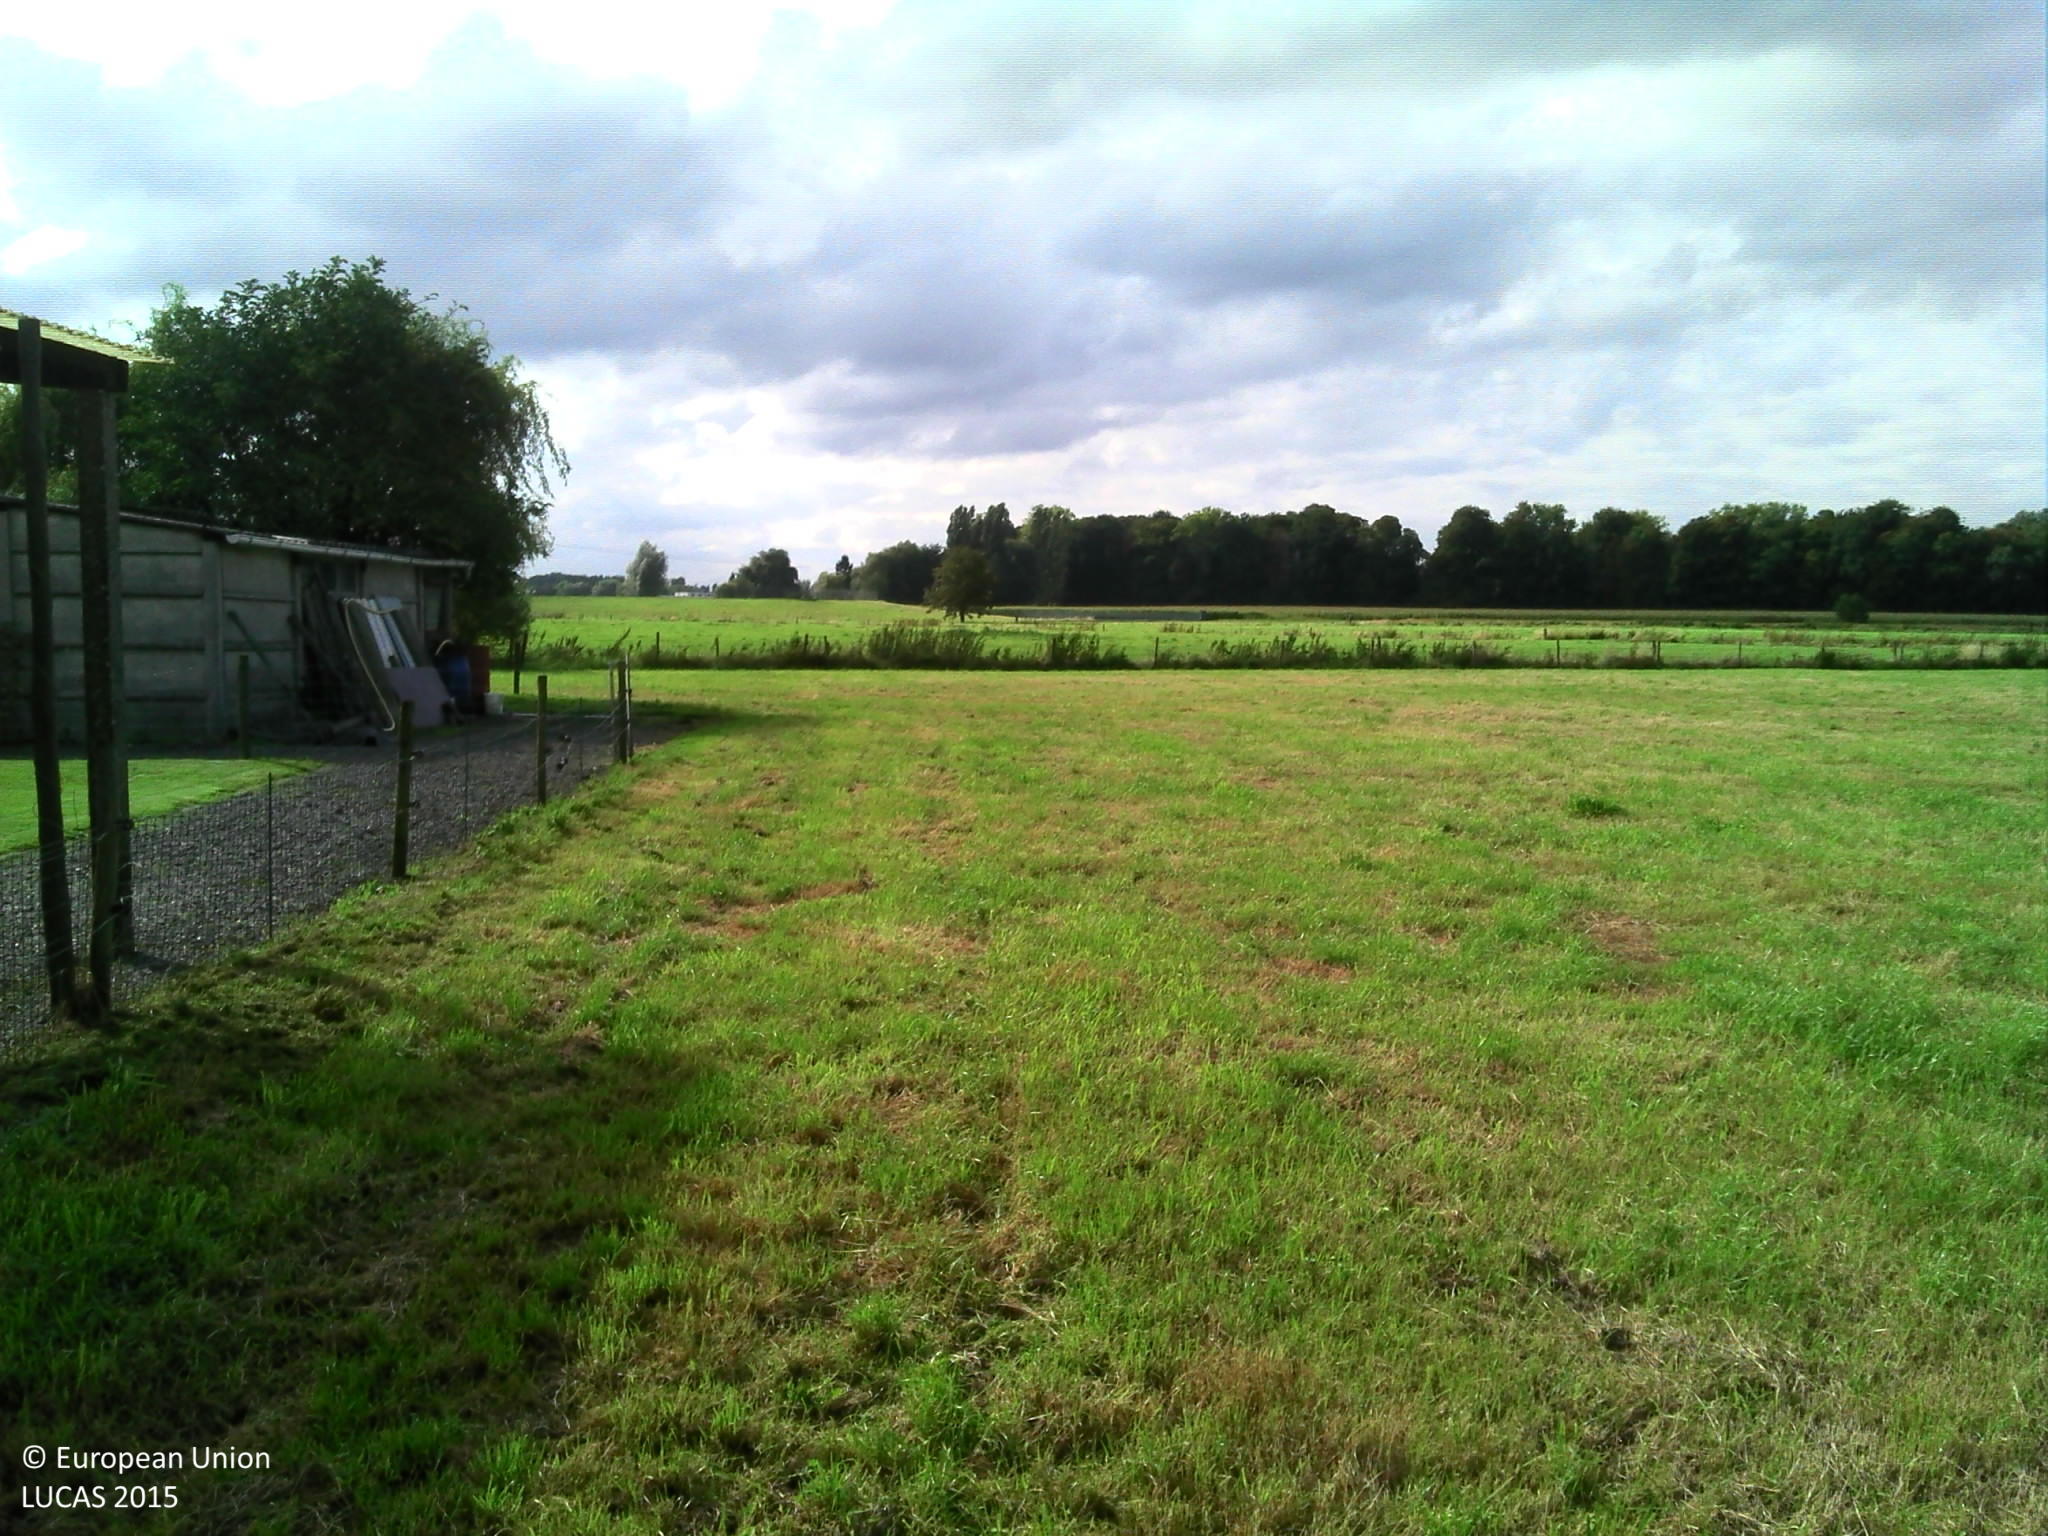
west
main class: Grassland
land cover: Grassland without tree/shrub cover
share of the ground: > 75 %
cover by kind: herbaceous plants 100 %
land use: Agriculture (excluding fallow land and kitchen gardens)
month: September
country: BE
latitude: 51.1877
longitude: 4.5160
